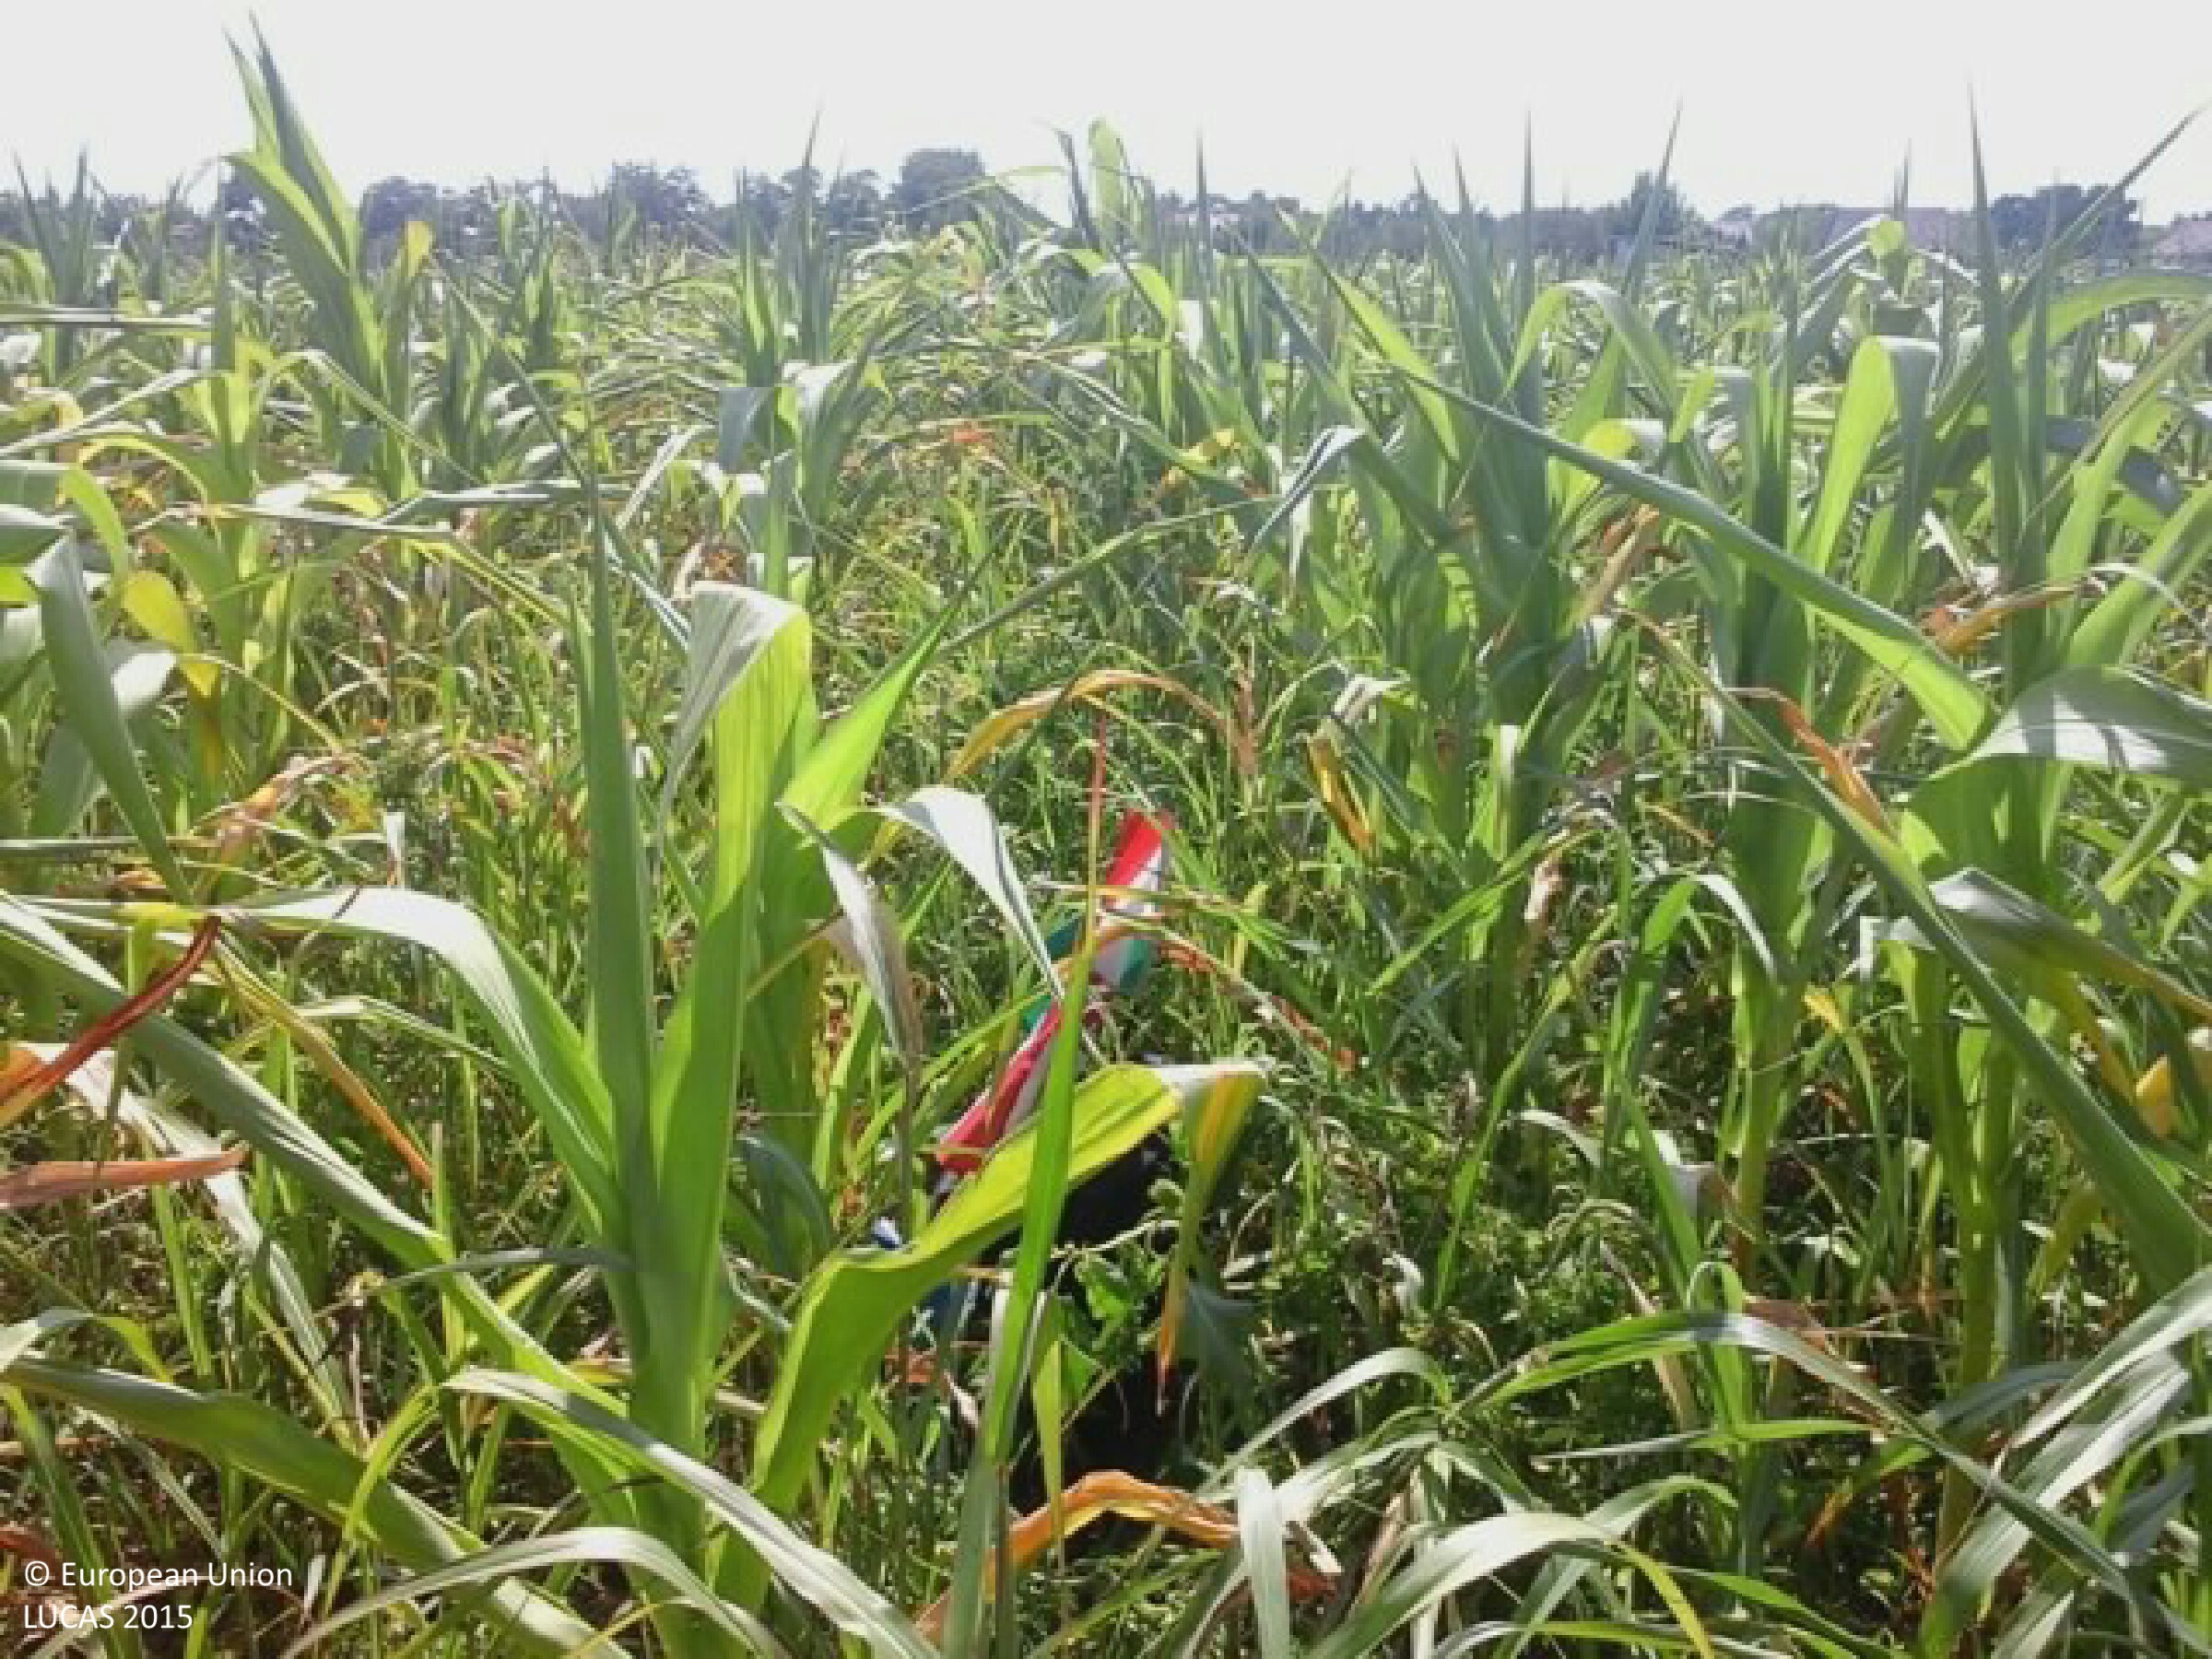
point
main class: Cropland
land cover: Maize
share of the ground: 50 - 75 %
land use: Agriculture (excluding fallow land and kitchen gardens)
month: July
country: HU
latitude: 47.2315
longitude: 19.0912
